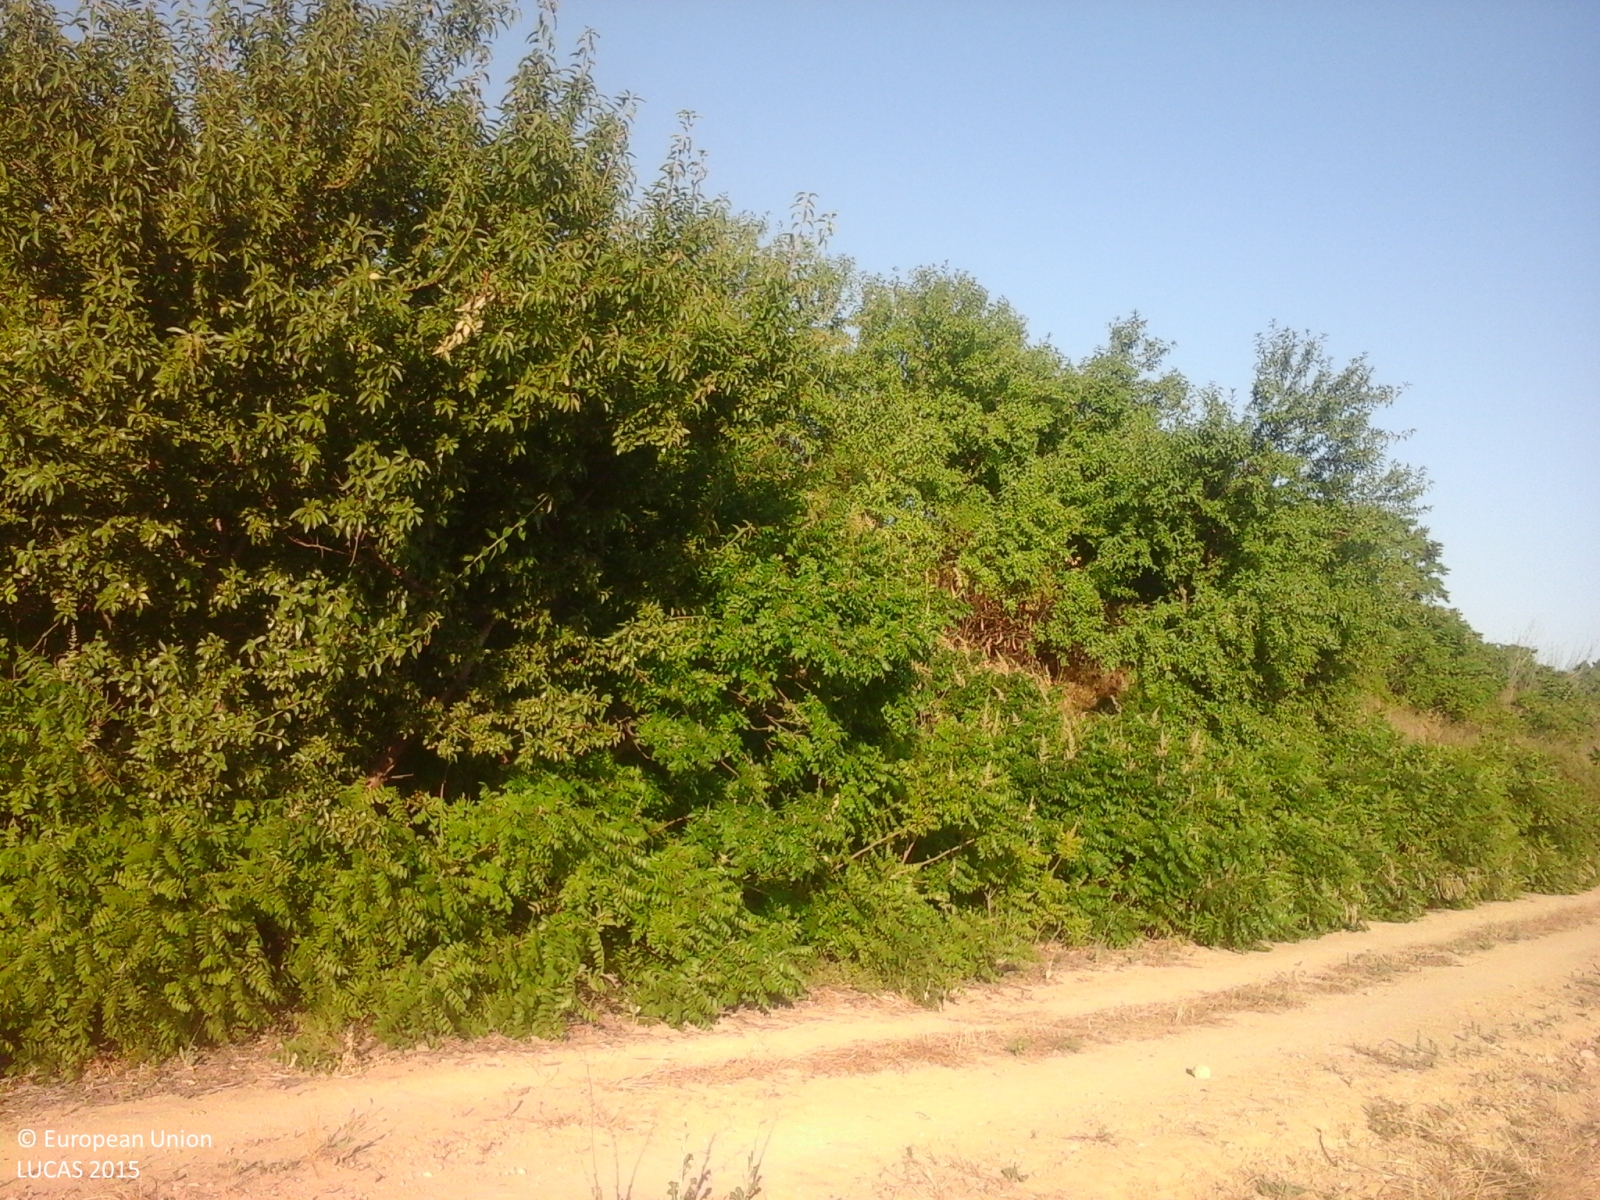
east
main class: Cropland
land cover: Vineyards
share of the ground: 10 - 25 %
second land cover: Other bare soil
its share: > 75 %
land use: Agriculture (excluding fallow land and kitchen gardens)
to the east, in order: Vineyards; Other bare soil; Tracks; Shrubland with sparse tree cover; Vineyards; Paved roads, cycling and walking lanes; Vineyards; Fences; Shrubland without tree cover; Inland fresh water bodies; Shrubland without tree cover; Vineyards; Grassland without tree/shrub cover; Olive groves; Spontaneously vegetated surfaces
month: May
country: IT
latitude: 37.6093
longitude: 13.0018
